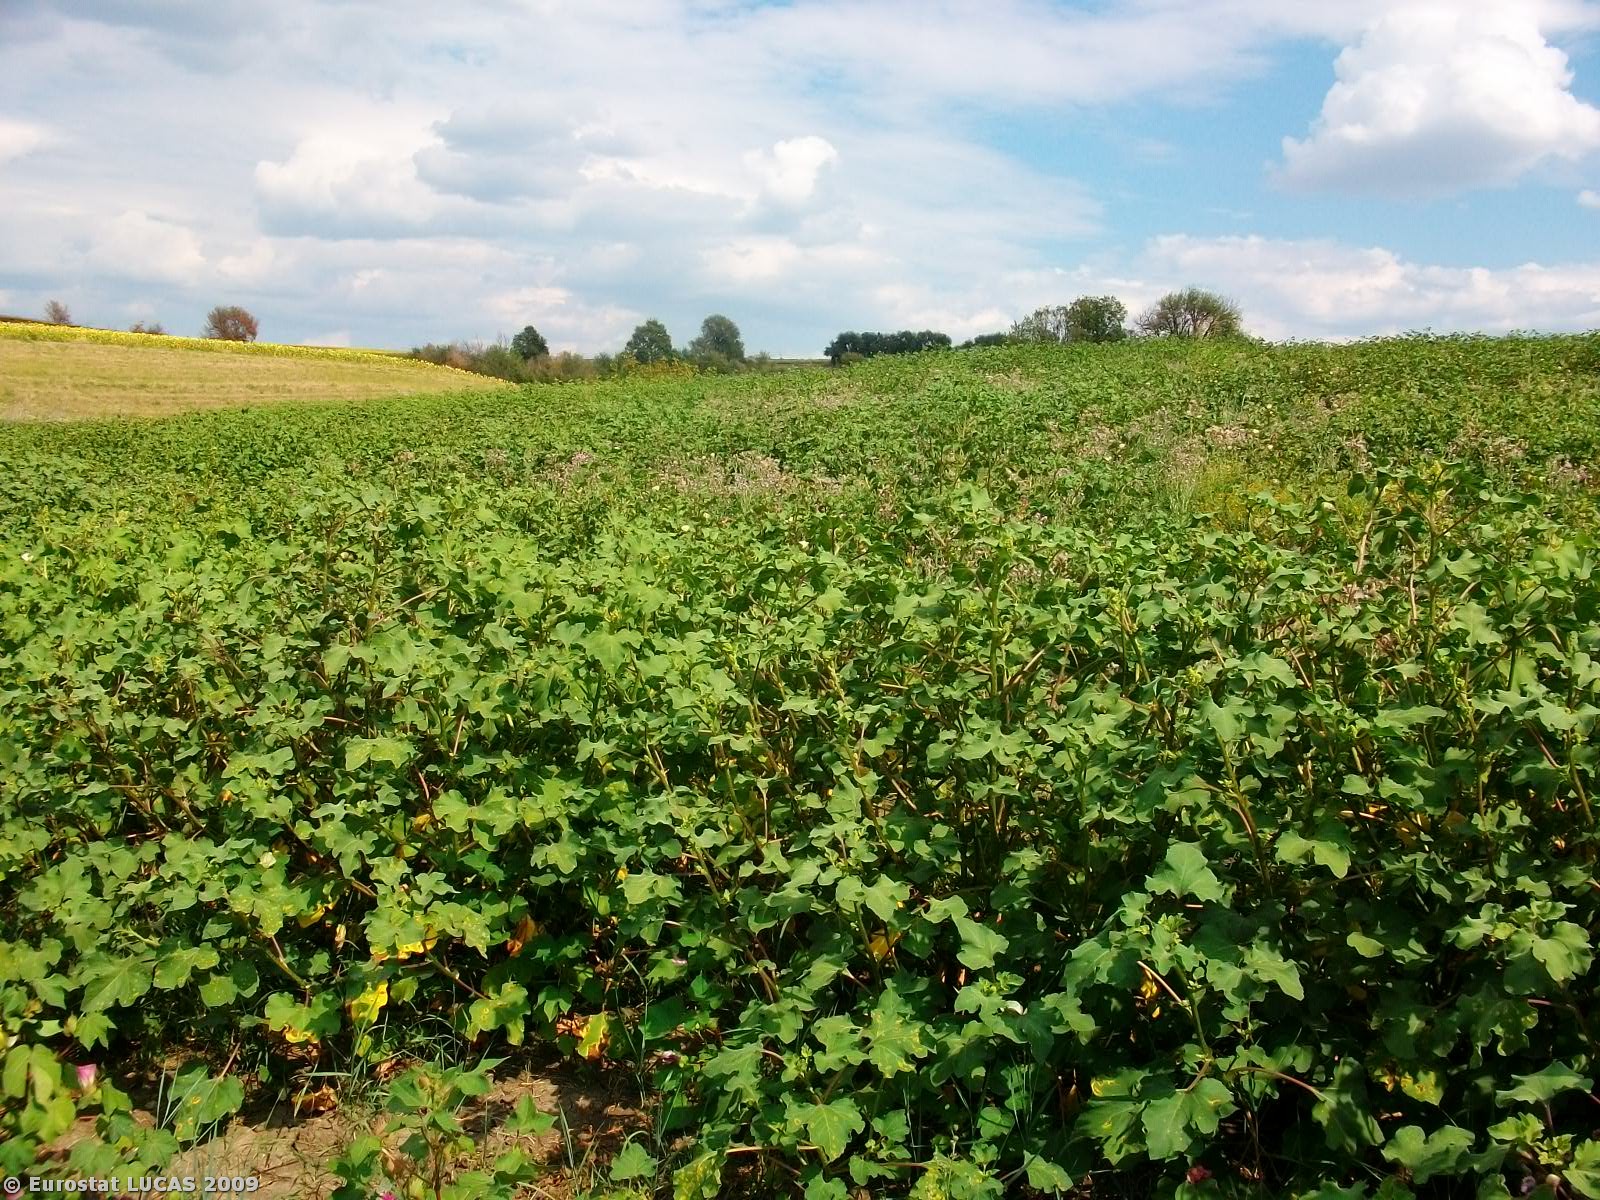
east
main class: Cropland
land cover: Cotton
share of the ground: 50 - 75 %
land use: Agriculture (excluding fallow land and kitchen gardens)
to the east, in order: Cotton; Grass margins; Common wheat; Sunflower; Grass margins; Common wheat
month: August
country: GR
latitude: 41.4980
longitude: 26.3550
